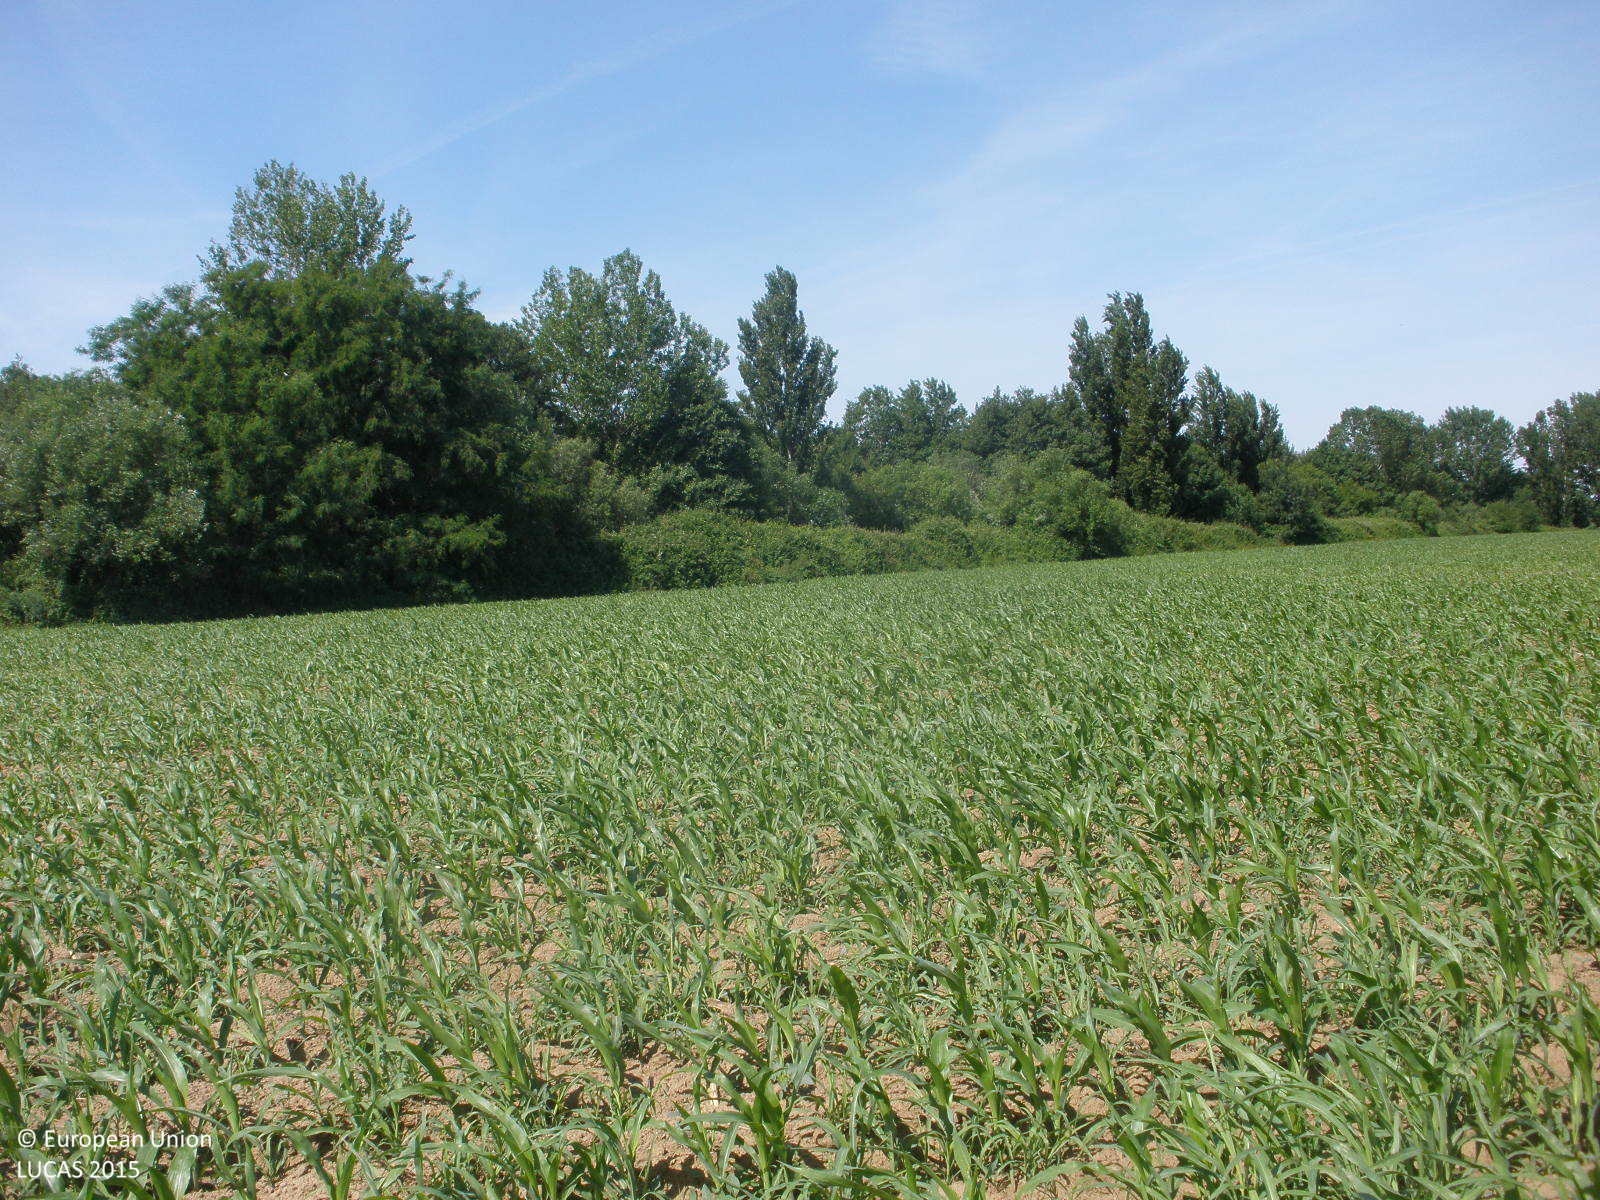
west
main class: Cropland
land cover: Maize
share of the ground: 50 - 75 %
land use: Agriculture (excluding fallow land and kitchen gardens)
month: May
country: ES
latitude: 40.0931
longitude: -6.6098
